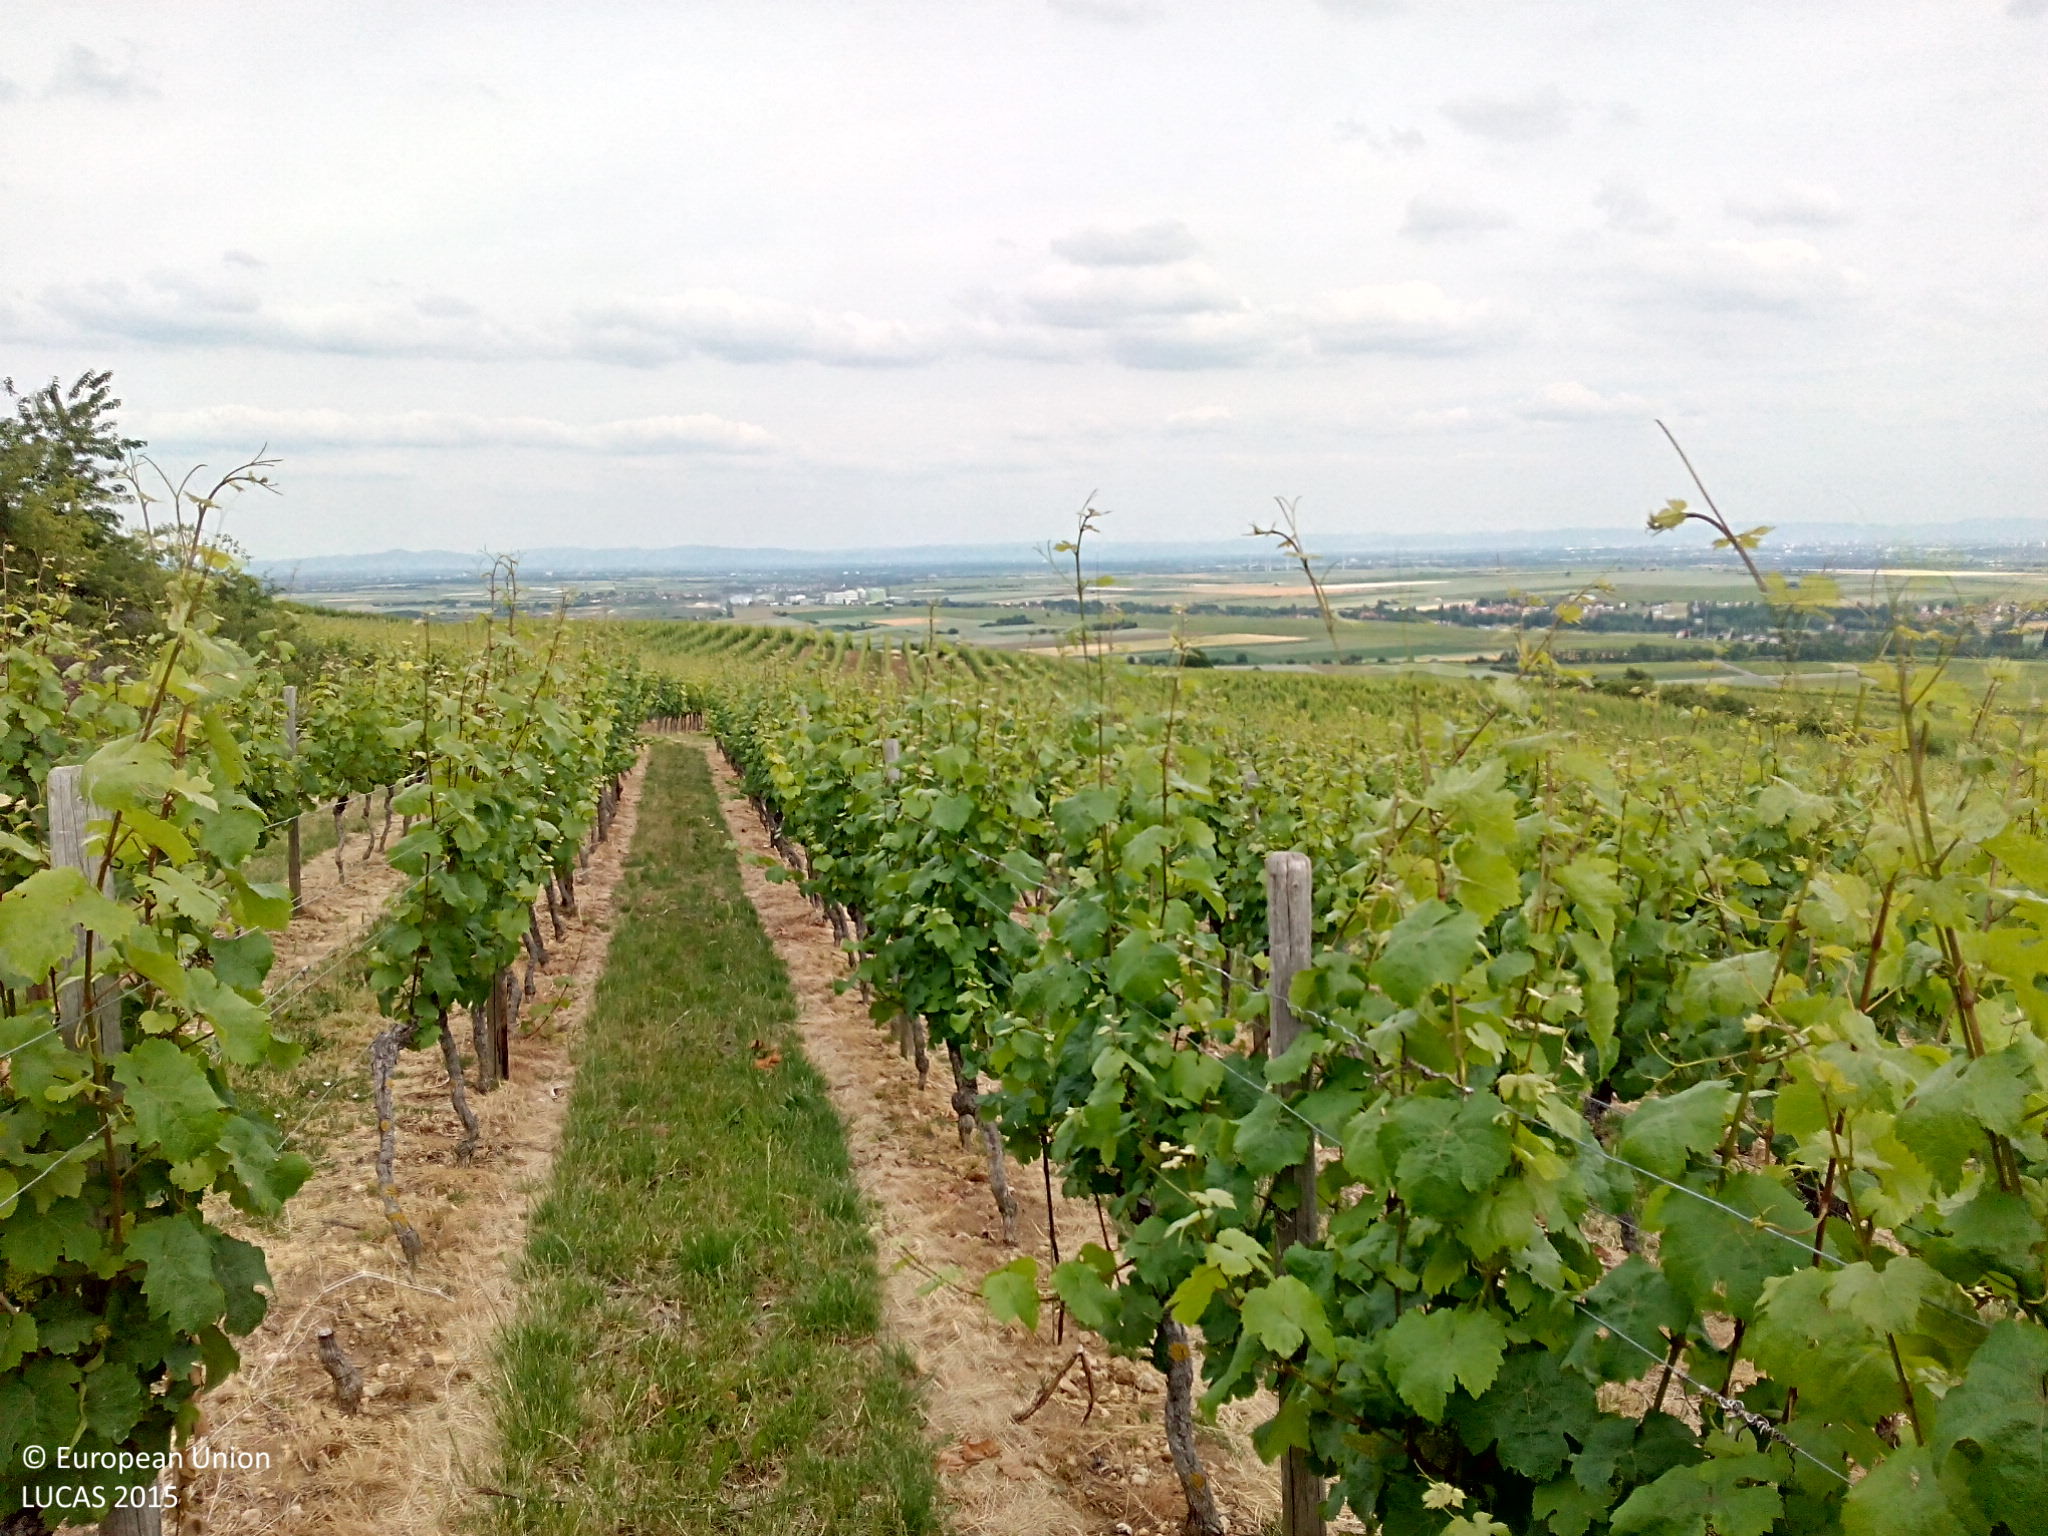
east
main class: Cropland
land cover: Vineyards
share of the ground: 10 - 25 %
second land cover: Grassland without tree/shrub cover
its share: 25 - 50 %
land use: Agriculture (excluding fallow land and kitchen gardens)
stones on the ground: 25 - 50 %
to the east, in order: Vineyards; Grassland without tree/shrub cover; Tracks; Spontaneously vegetated surfaces; Vineyards; Tracks; Spontaneously vegetated surfaces; Vineyards
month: June
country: DE
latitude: 49.5938
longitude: 8.1605
